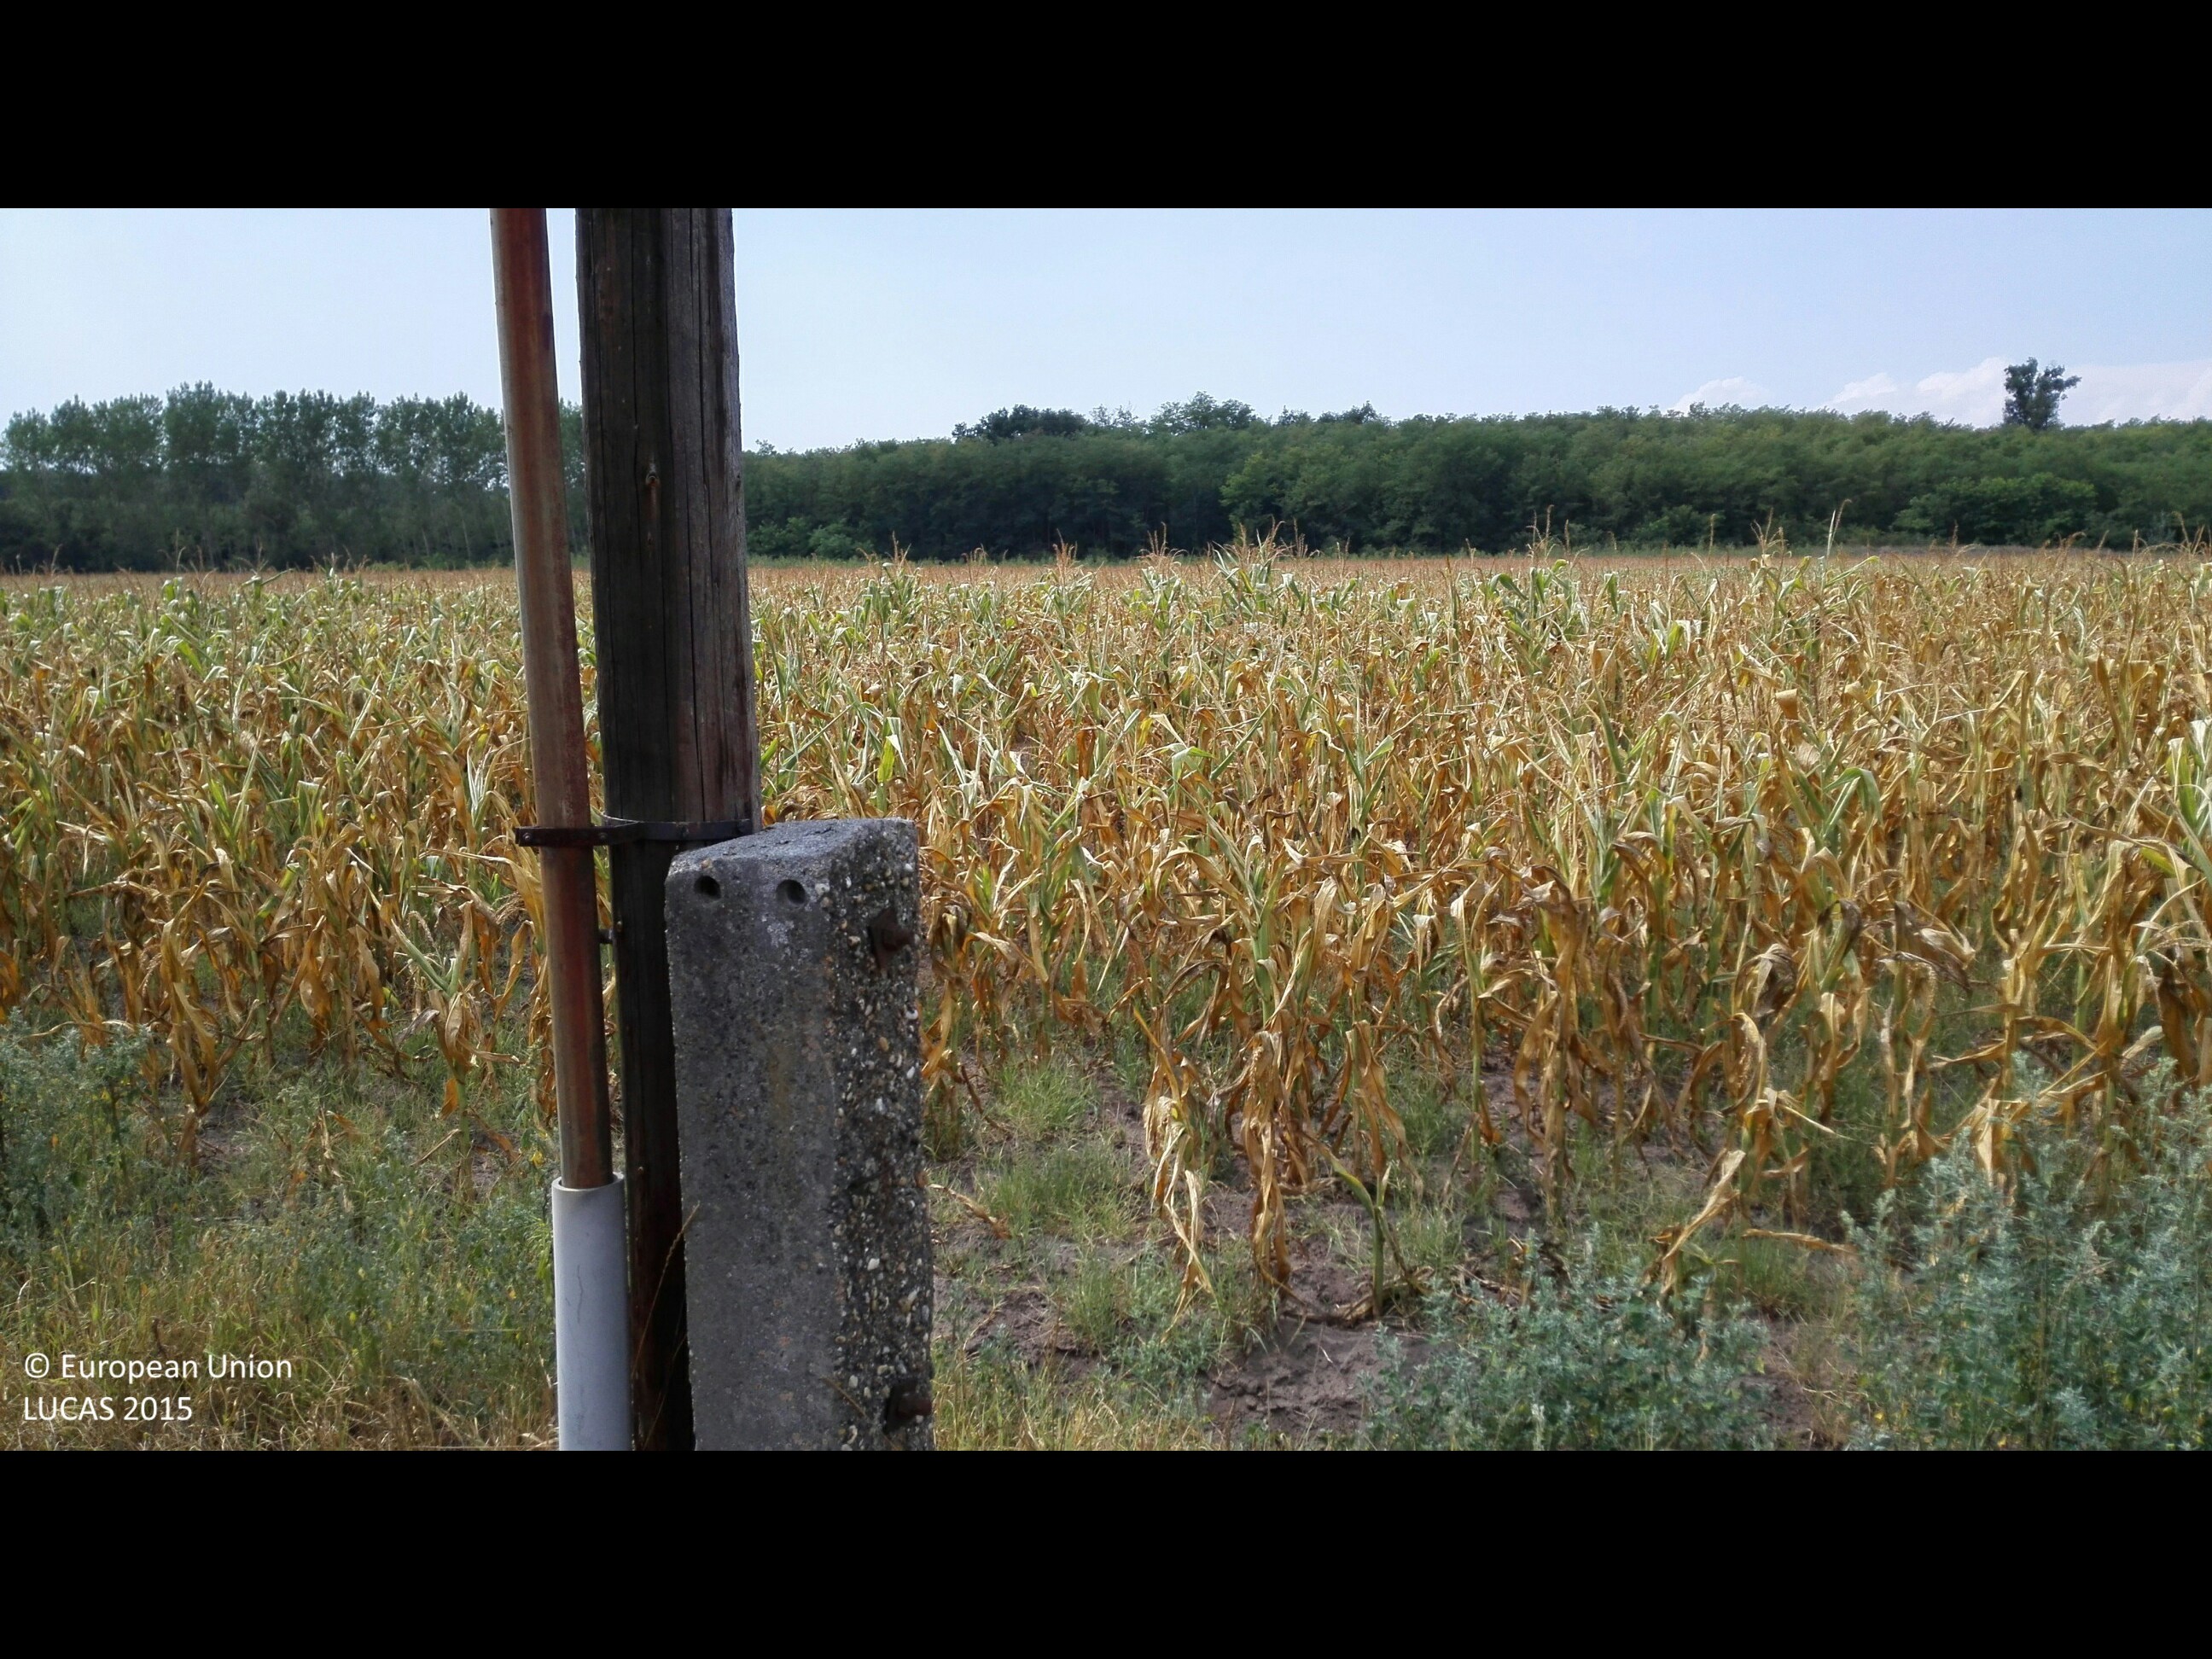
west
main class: Grassland
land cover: Grassland with sparse tree/shrub cover
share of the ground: > 75 %
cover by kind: herbaceous plants 90 %, broadleaved forest trees 5 %, shrubs 5 %
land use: Residential
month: August
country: HU
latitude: 47.5650
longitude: 21.8373
